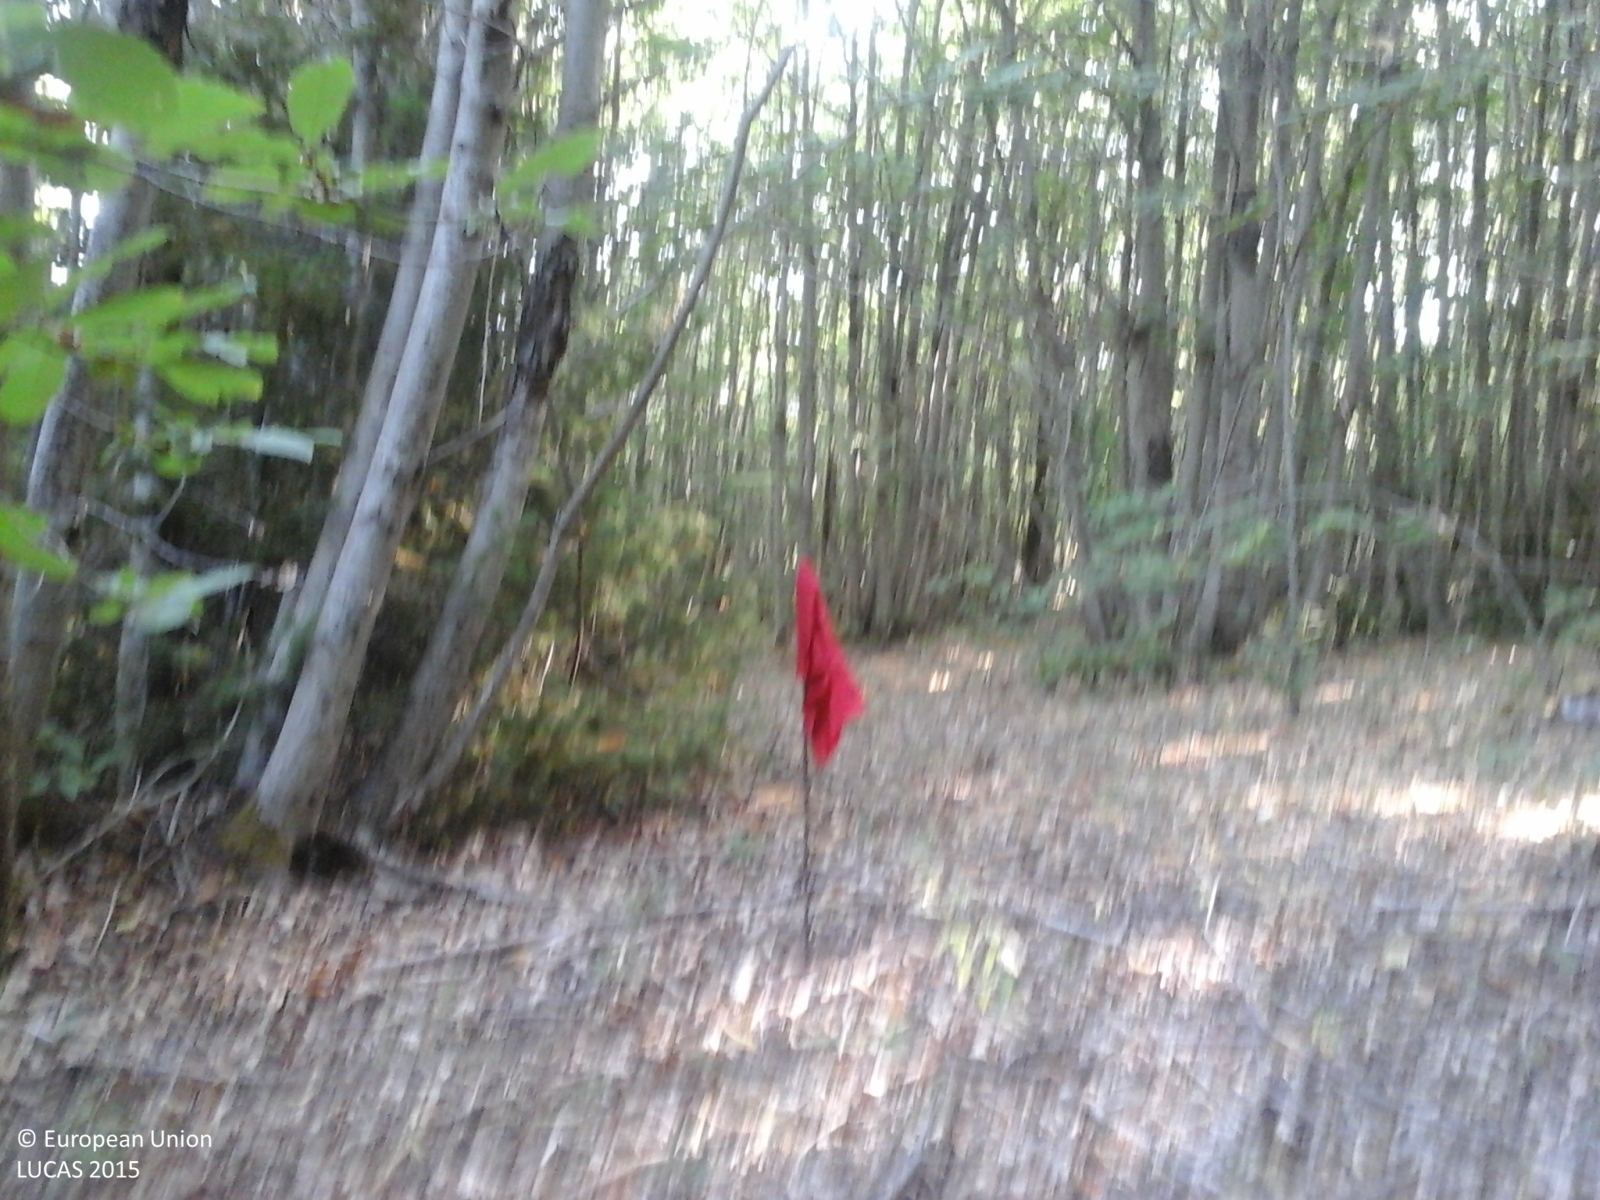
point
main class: Woodland
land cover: Broadleaved woodland
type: thermophilous deciduous forest
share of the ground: > 75 %
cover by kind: broadleaved forest trees 85 %, shrubs 10 %, herbaceous plants 5 %
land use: Forestry
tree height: > 5 m
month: July
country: IT
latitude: 42.8946
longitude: 11.5747
